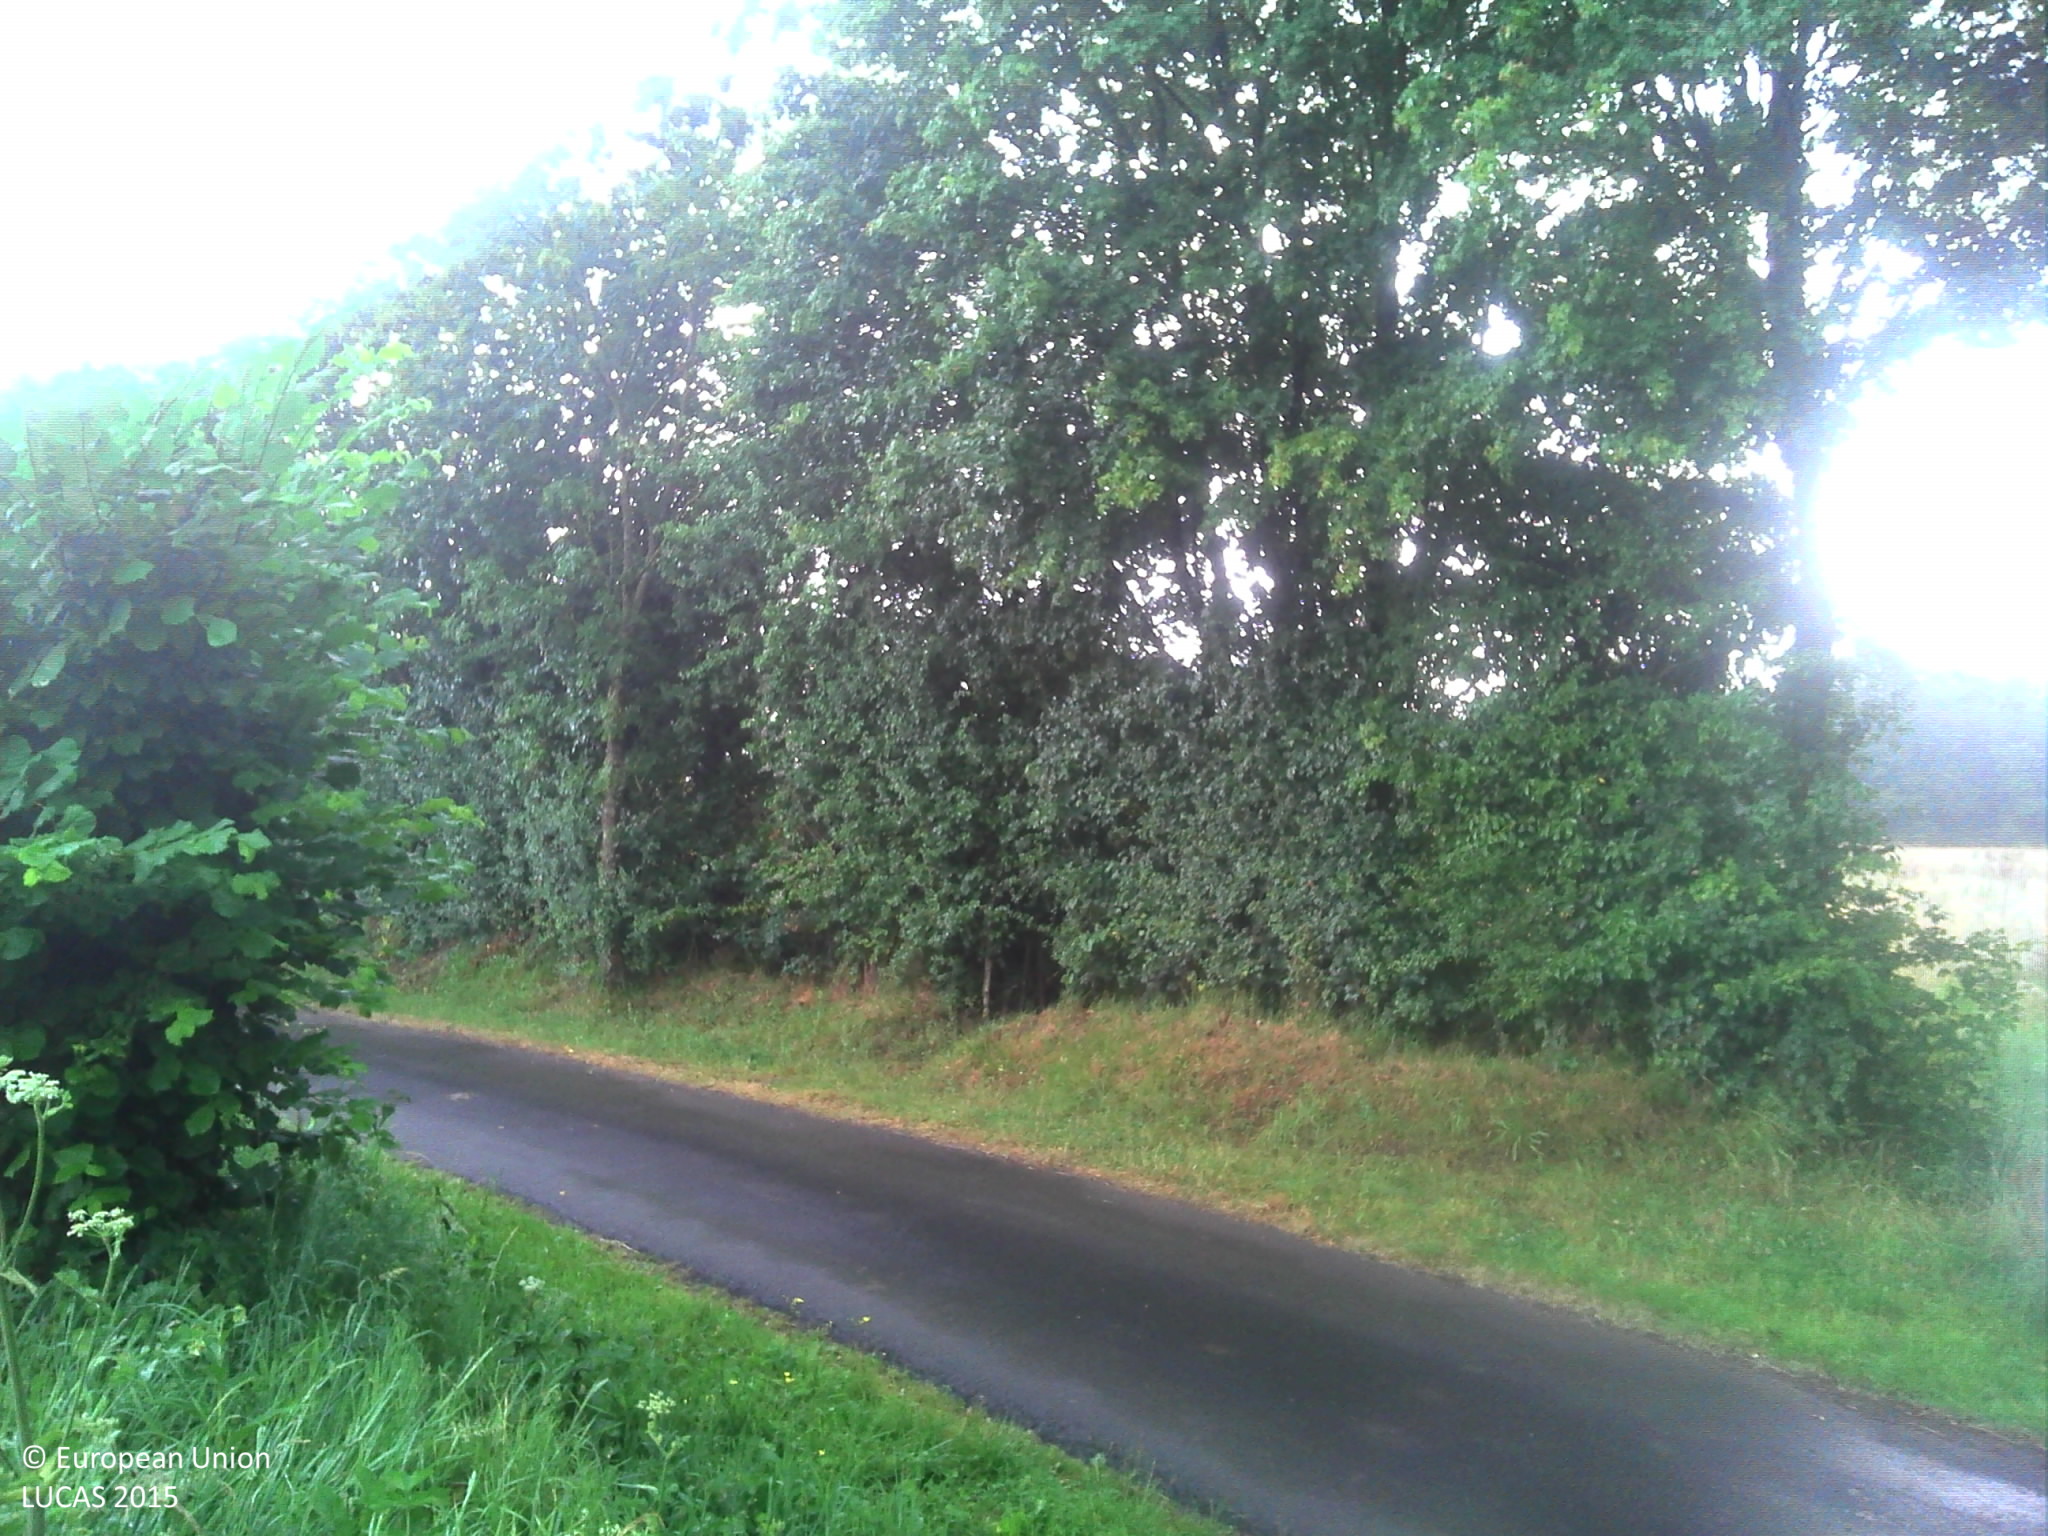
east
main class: Grassland
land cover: Grassland without tree/shrub cover
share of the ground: > 75 %
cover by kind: herbaceous plants 100 %
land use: Agriculture (excluding fallow land and kitchen gardens)
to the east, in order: Grassland without tree/shrub cover; Fences; Lines of trees; Ditches and canals; Electric lines; Grass margins; Paved roads, cycling and walking lanes; Grass margins; Electric lines; Lines of trees; Grassland without tree/shrub cover; Broadleaved woodland; Fences; Grassland without tree/shrub cover; Fences; Triticale
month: July
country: FR
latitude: 48.1433
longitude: 0.5554
